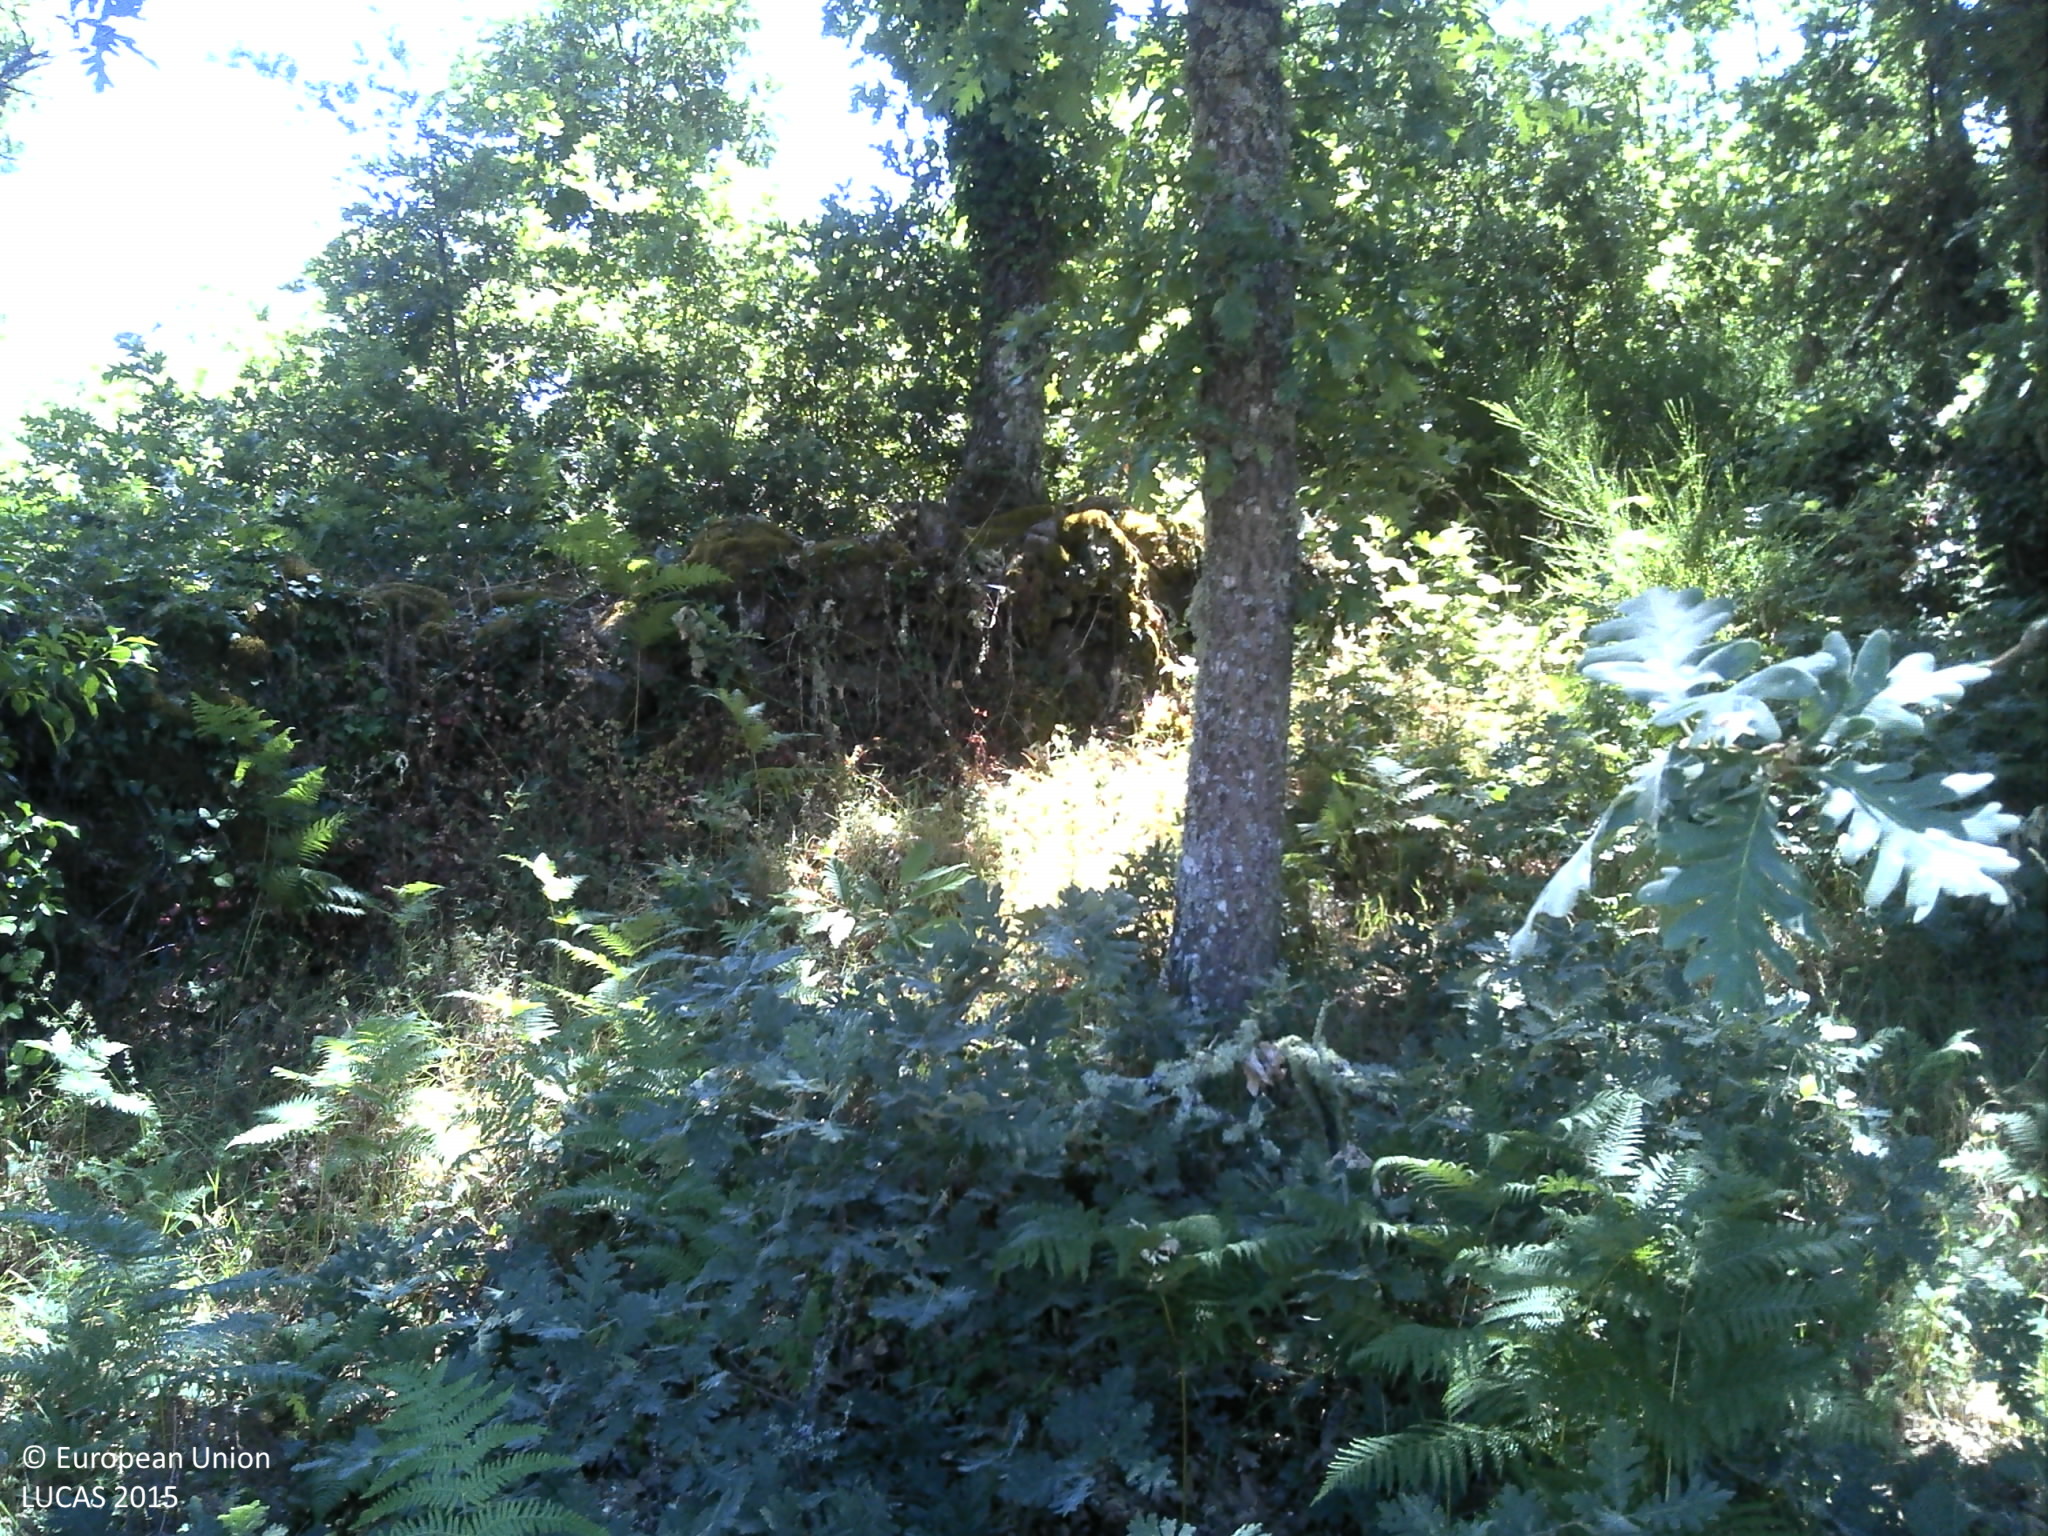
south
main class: Grassland
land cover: Spontaneously vegetated surfaces
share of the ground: > 75 %
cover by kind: herbaceous plants 95 %, unconsolidated bare surface 5 %
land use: Fallow land
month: June
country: PT
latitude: 40.7825
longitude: -7.3046
